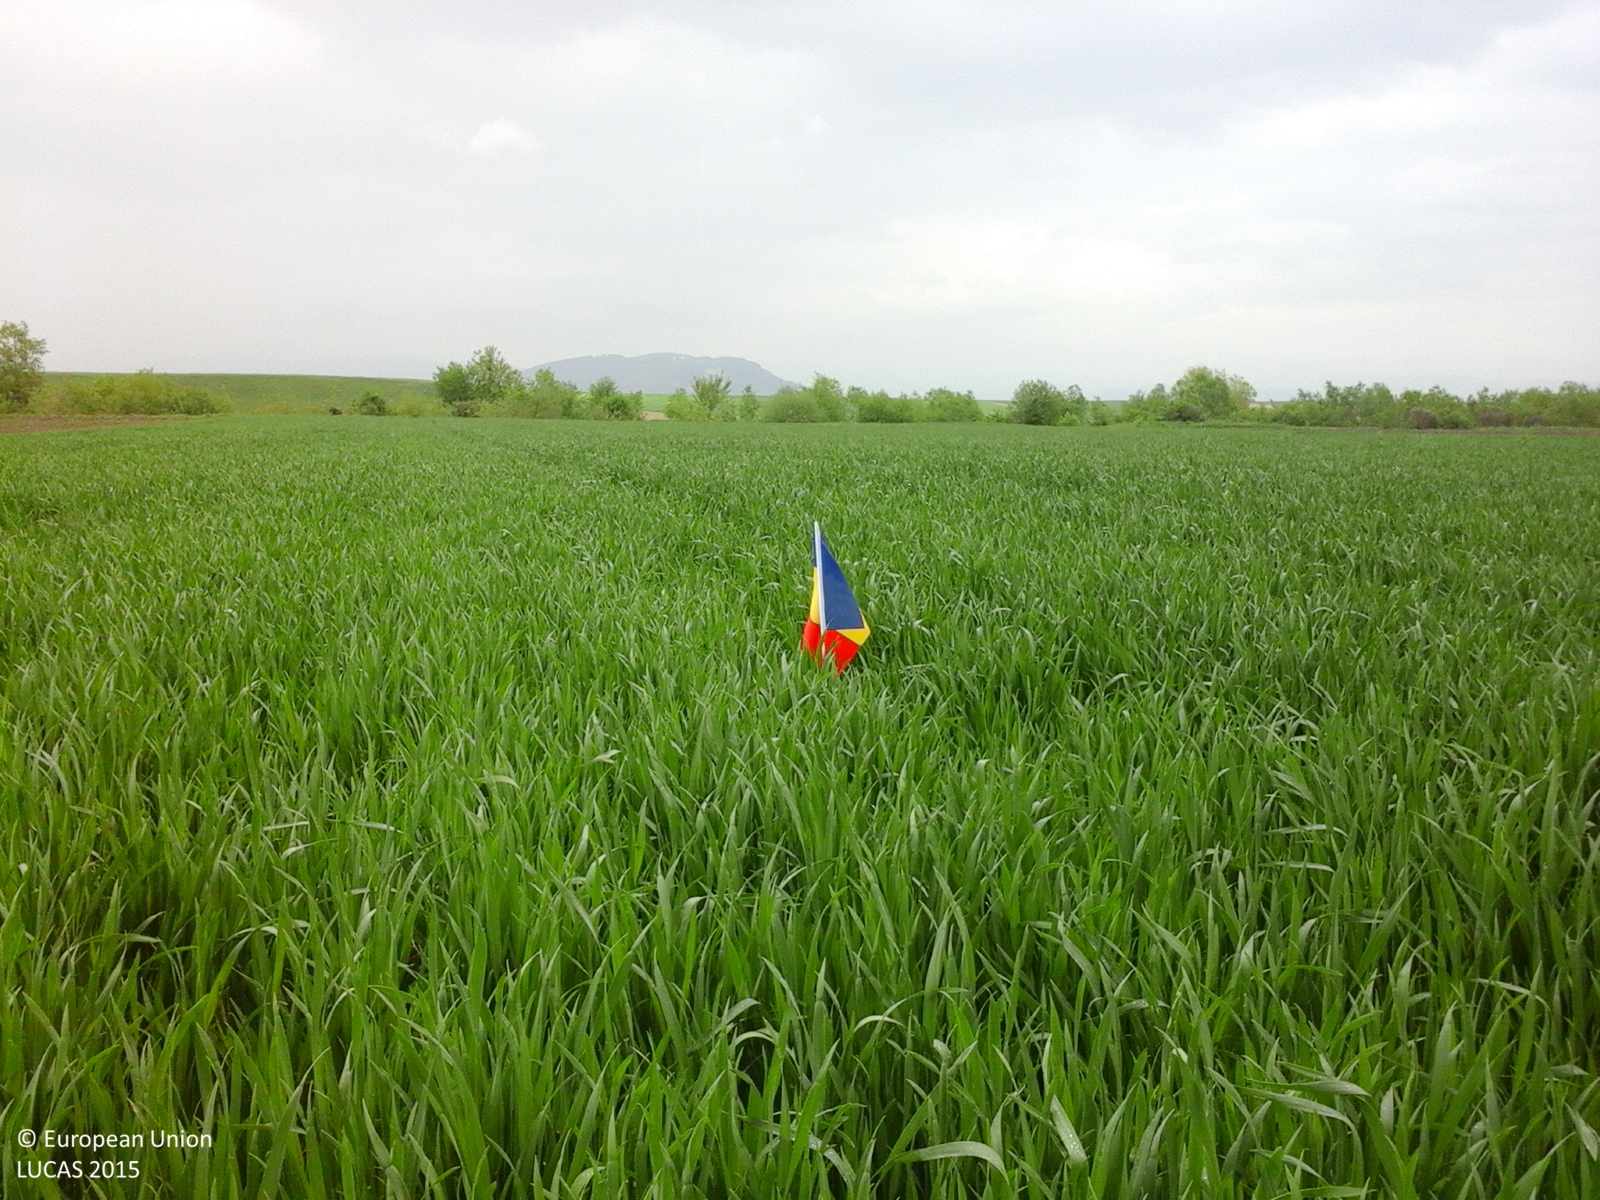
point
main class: Cropland
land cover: Common wheat
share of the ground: > 75 %
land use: Fallow land
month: May
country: RO
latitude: 46.0209
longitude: 26.0984
